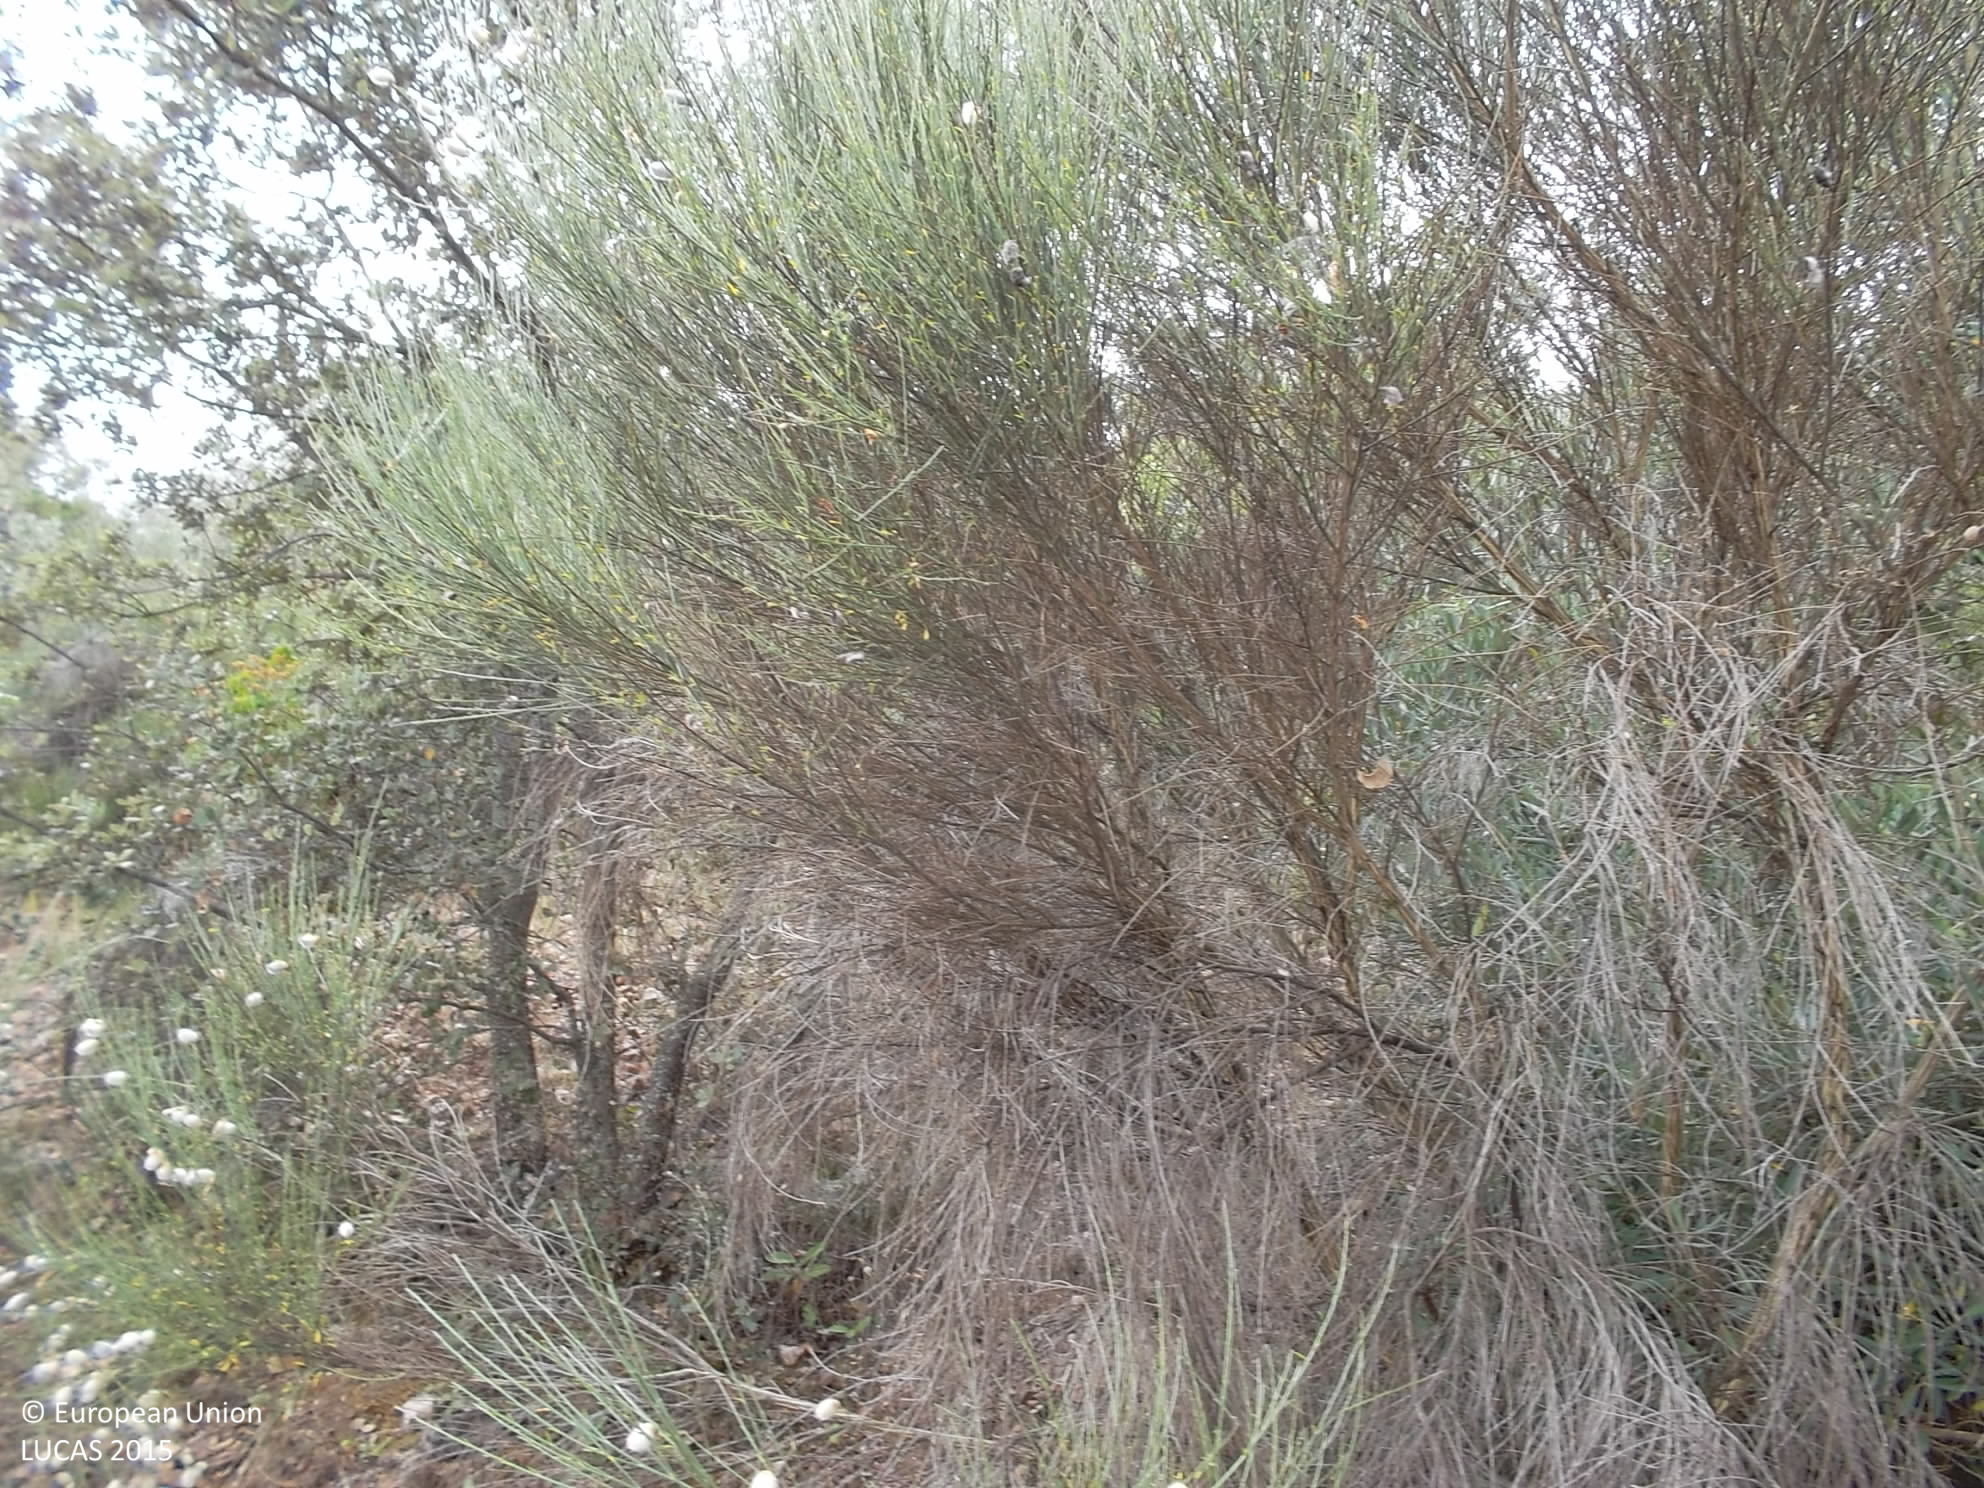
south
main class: Cropland
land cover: Olive groves
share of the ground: 25 - 50 %
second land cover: Shrubland without tree cover
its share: 50 - 75 %
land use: Agriculture (excluding fallow land and kitchen gardens)
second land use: Forestry
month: June
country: ES
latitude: 39.2111
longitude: -4.8019
